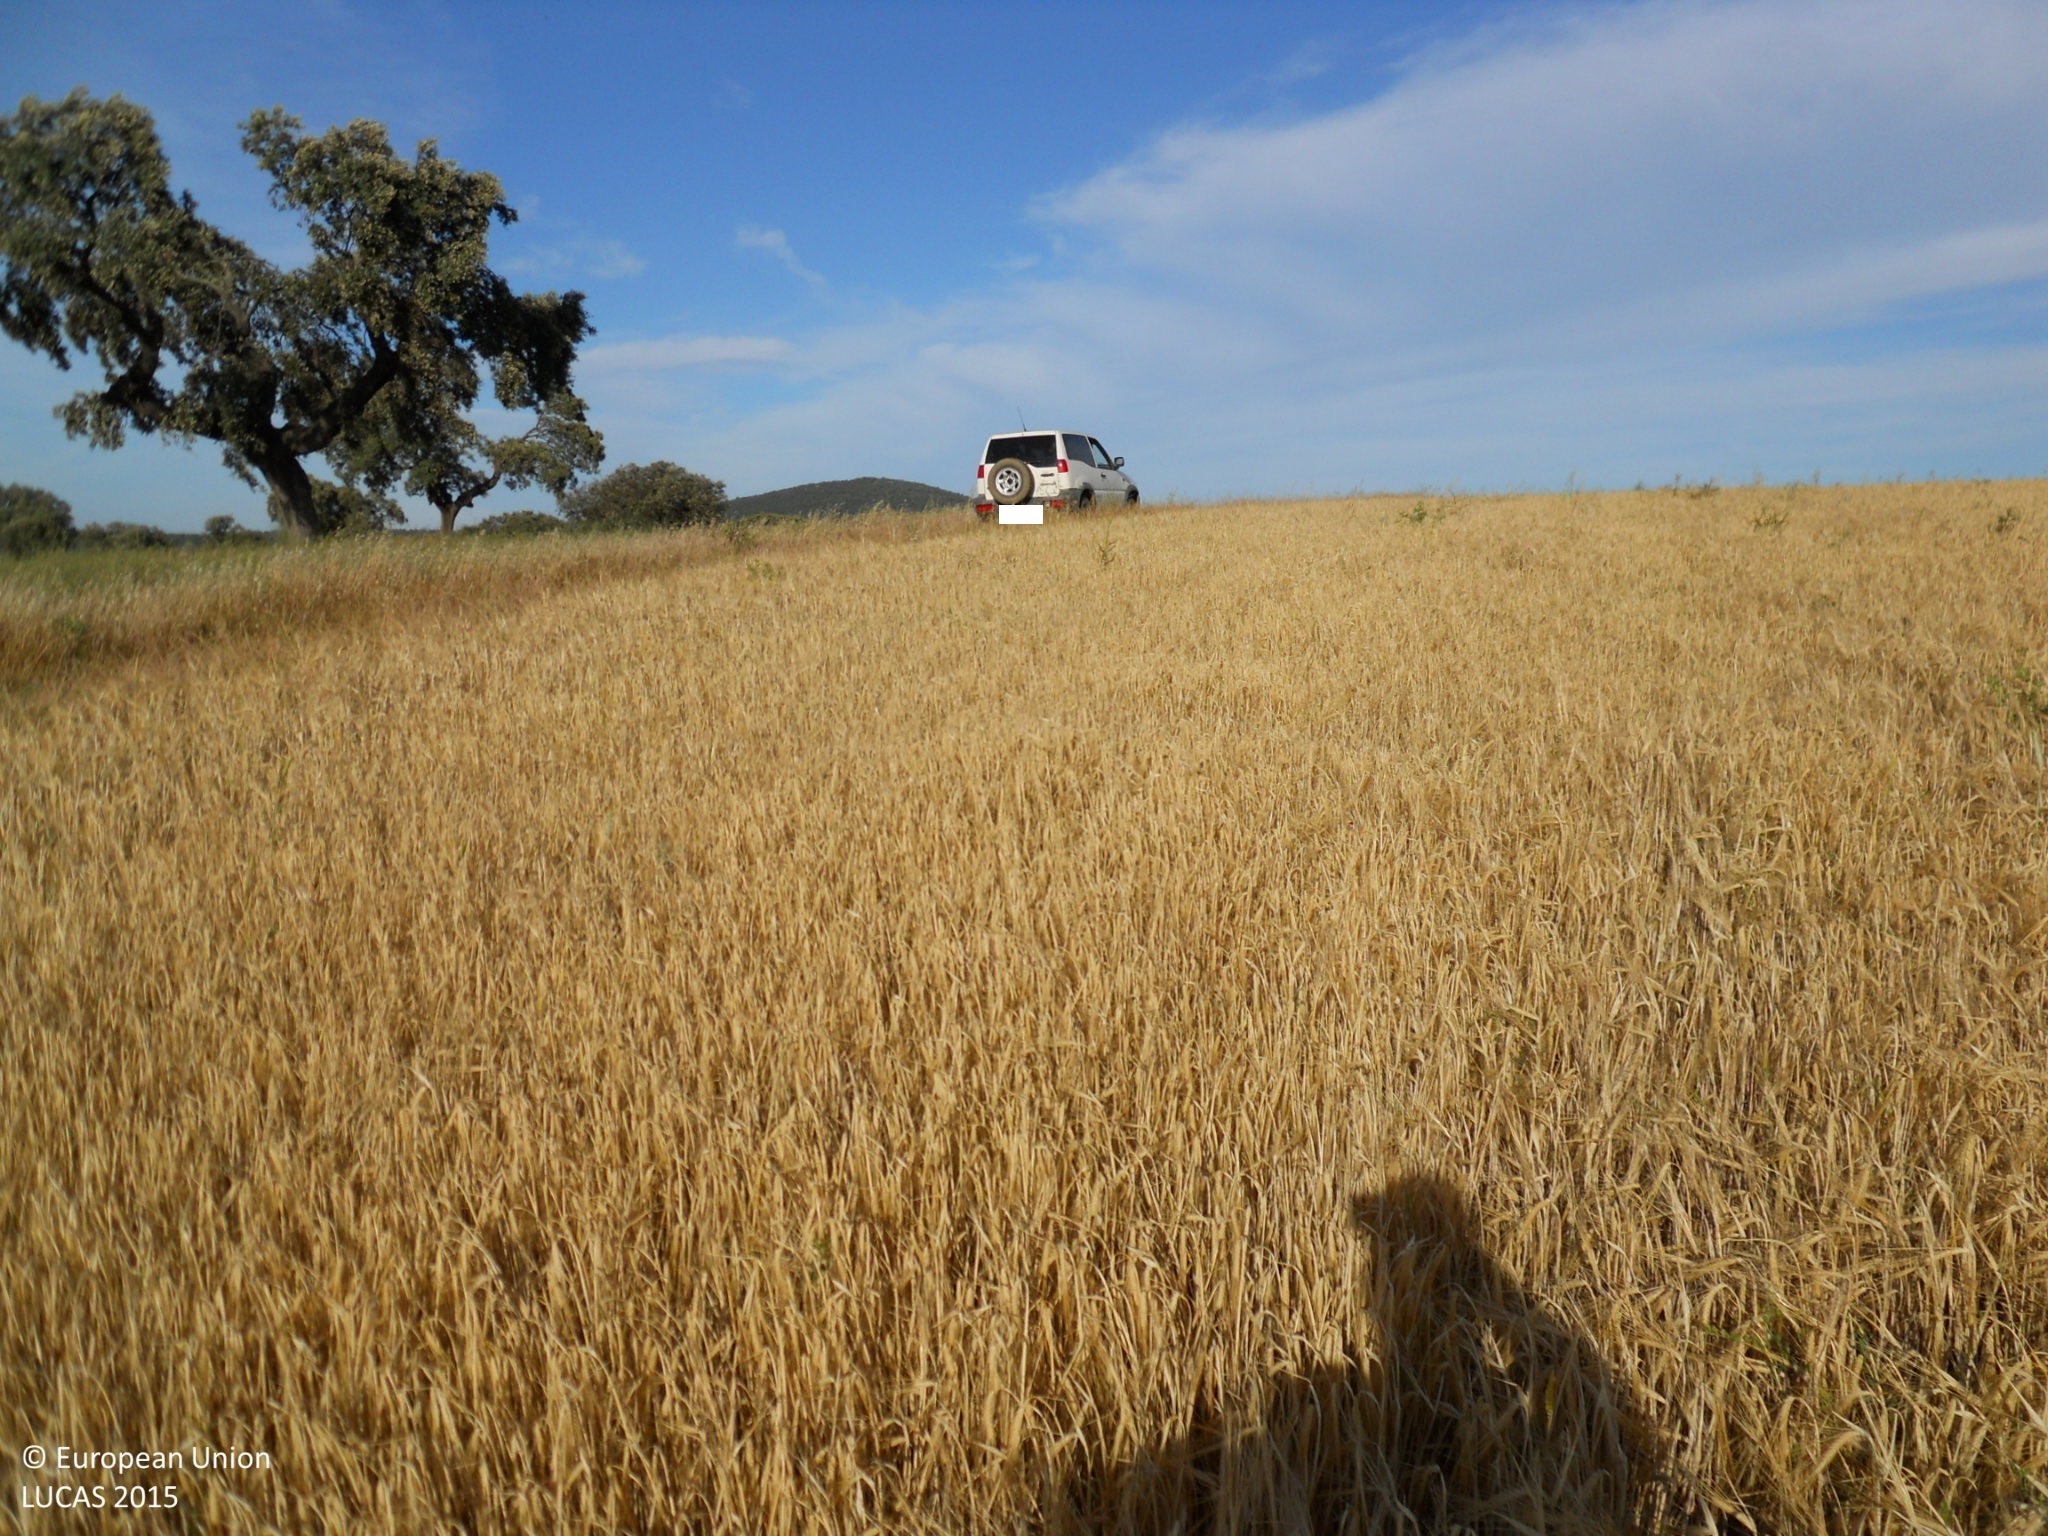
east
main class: Cropland
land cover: Rye
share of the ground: > 75 %
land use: Agriculture (excluding fallow land and kitchen gardens)
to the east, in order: Rye; Tracks; Grassland with sparse tree/shrub cover; Dry stone walls; Fences; Barley; Fences; Broadleaved woodland
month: May
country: ES
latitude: 39.0387
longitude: -6.3143
